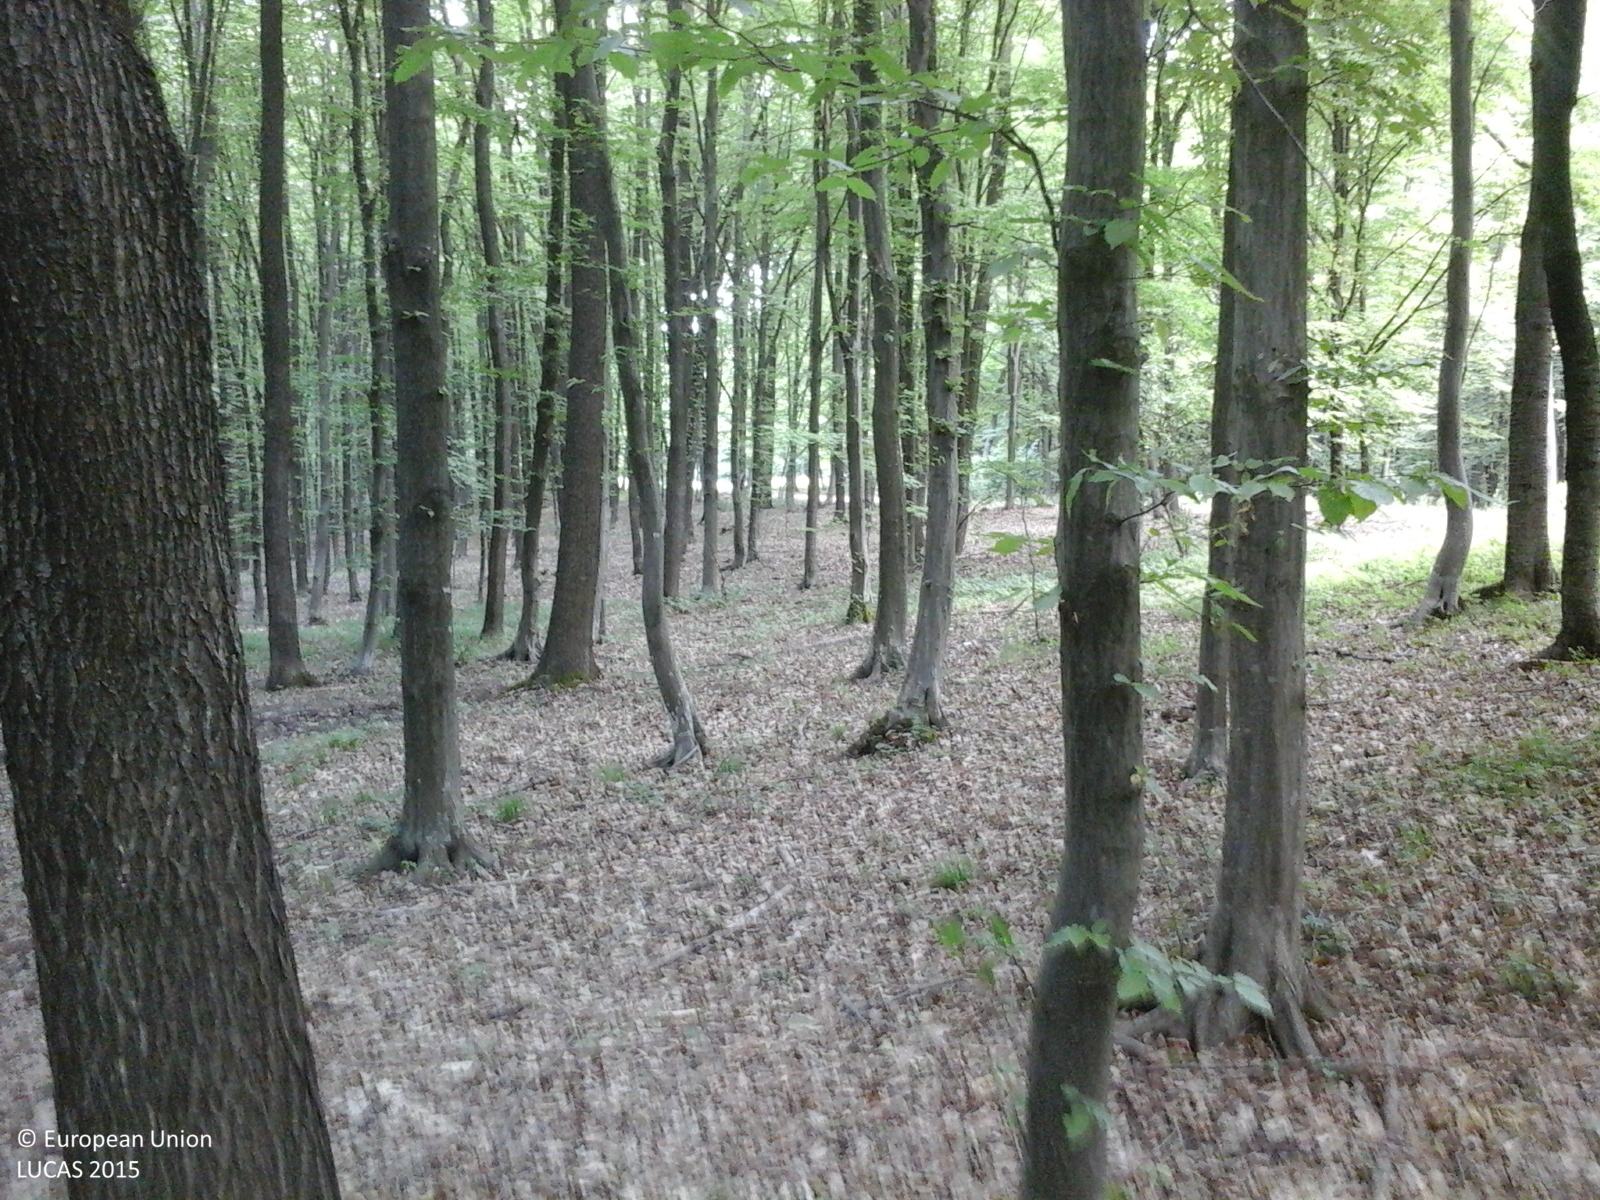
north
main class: Woodland
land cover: Broadleaved woodland
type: beech forest
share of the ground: > 75 %
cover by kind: broadleaved forest trees 95 %, herbaceous plants 5 %
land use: Forestry
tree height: > 5 m
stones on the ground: < 10 %
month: June
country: RO
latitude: 47.8543
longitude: 26.3524
